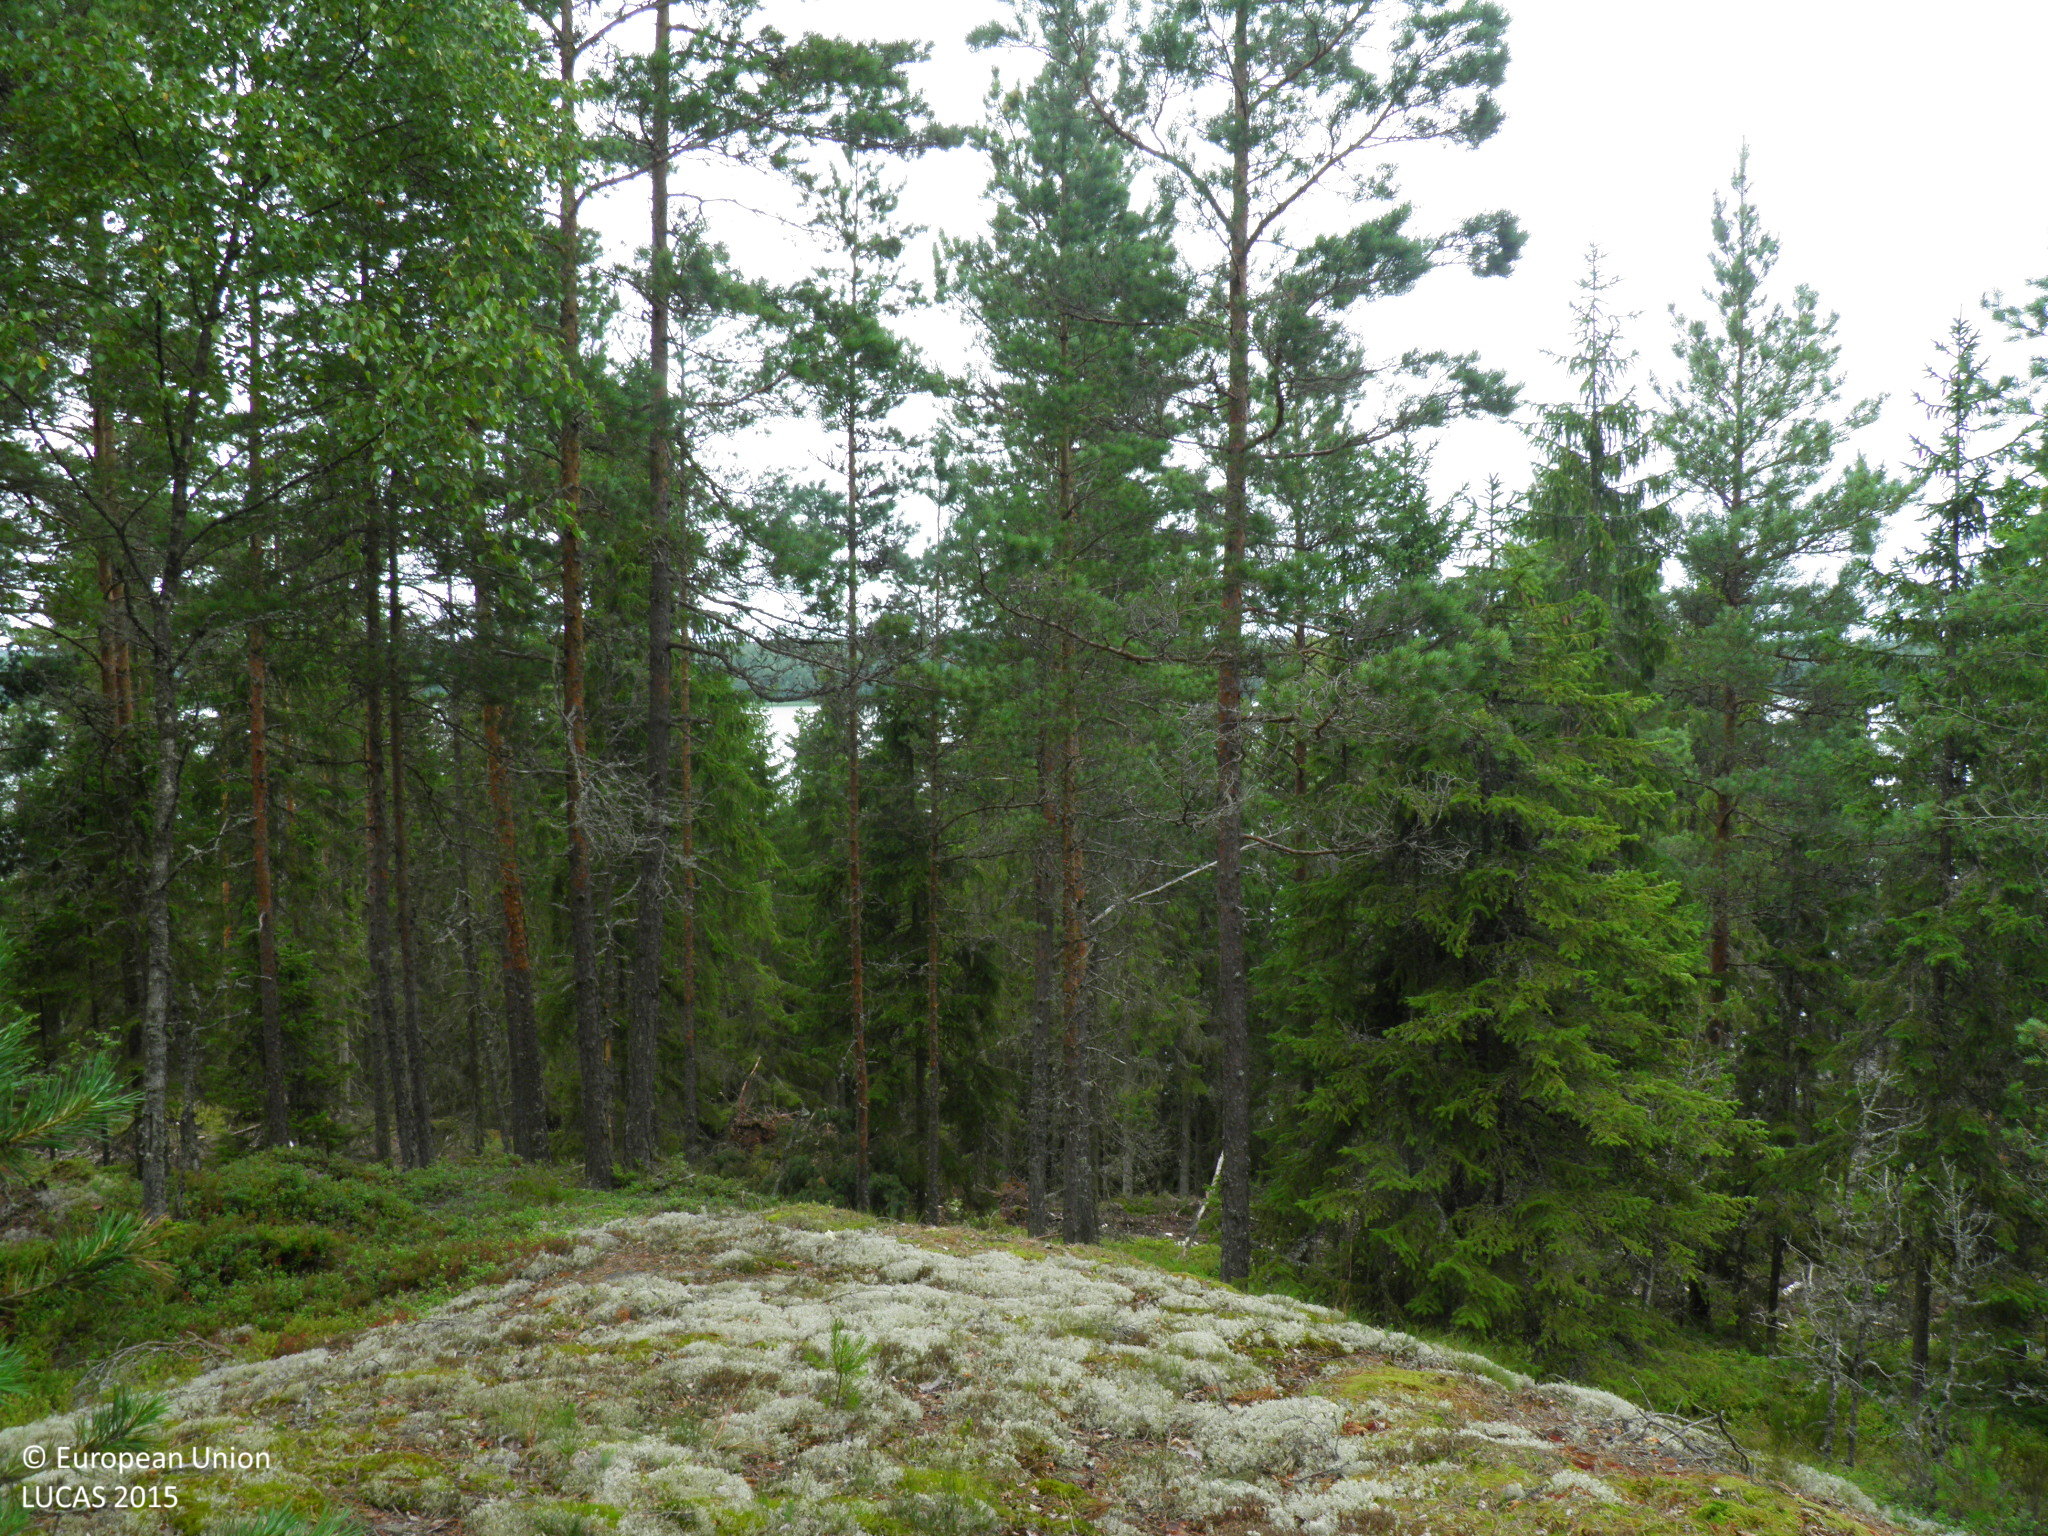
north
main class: Woodland
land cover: Pine dominated coniferous woodland
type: hemiboreal forest and nemoral coniferous forest and mixed broadleaved-coniferous forest
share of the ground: 25 - 50 %
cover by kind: coniferous forest trees 40 %, shrubs 30 %, lichens and mosses 30 %
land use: Forestry
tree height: > 5 m
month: July
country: FI
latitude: 60.2286
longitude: 22.6586
